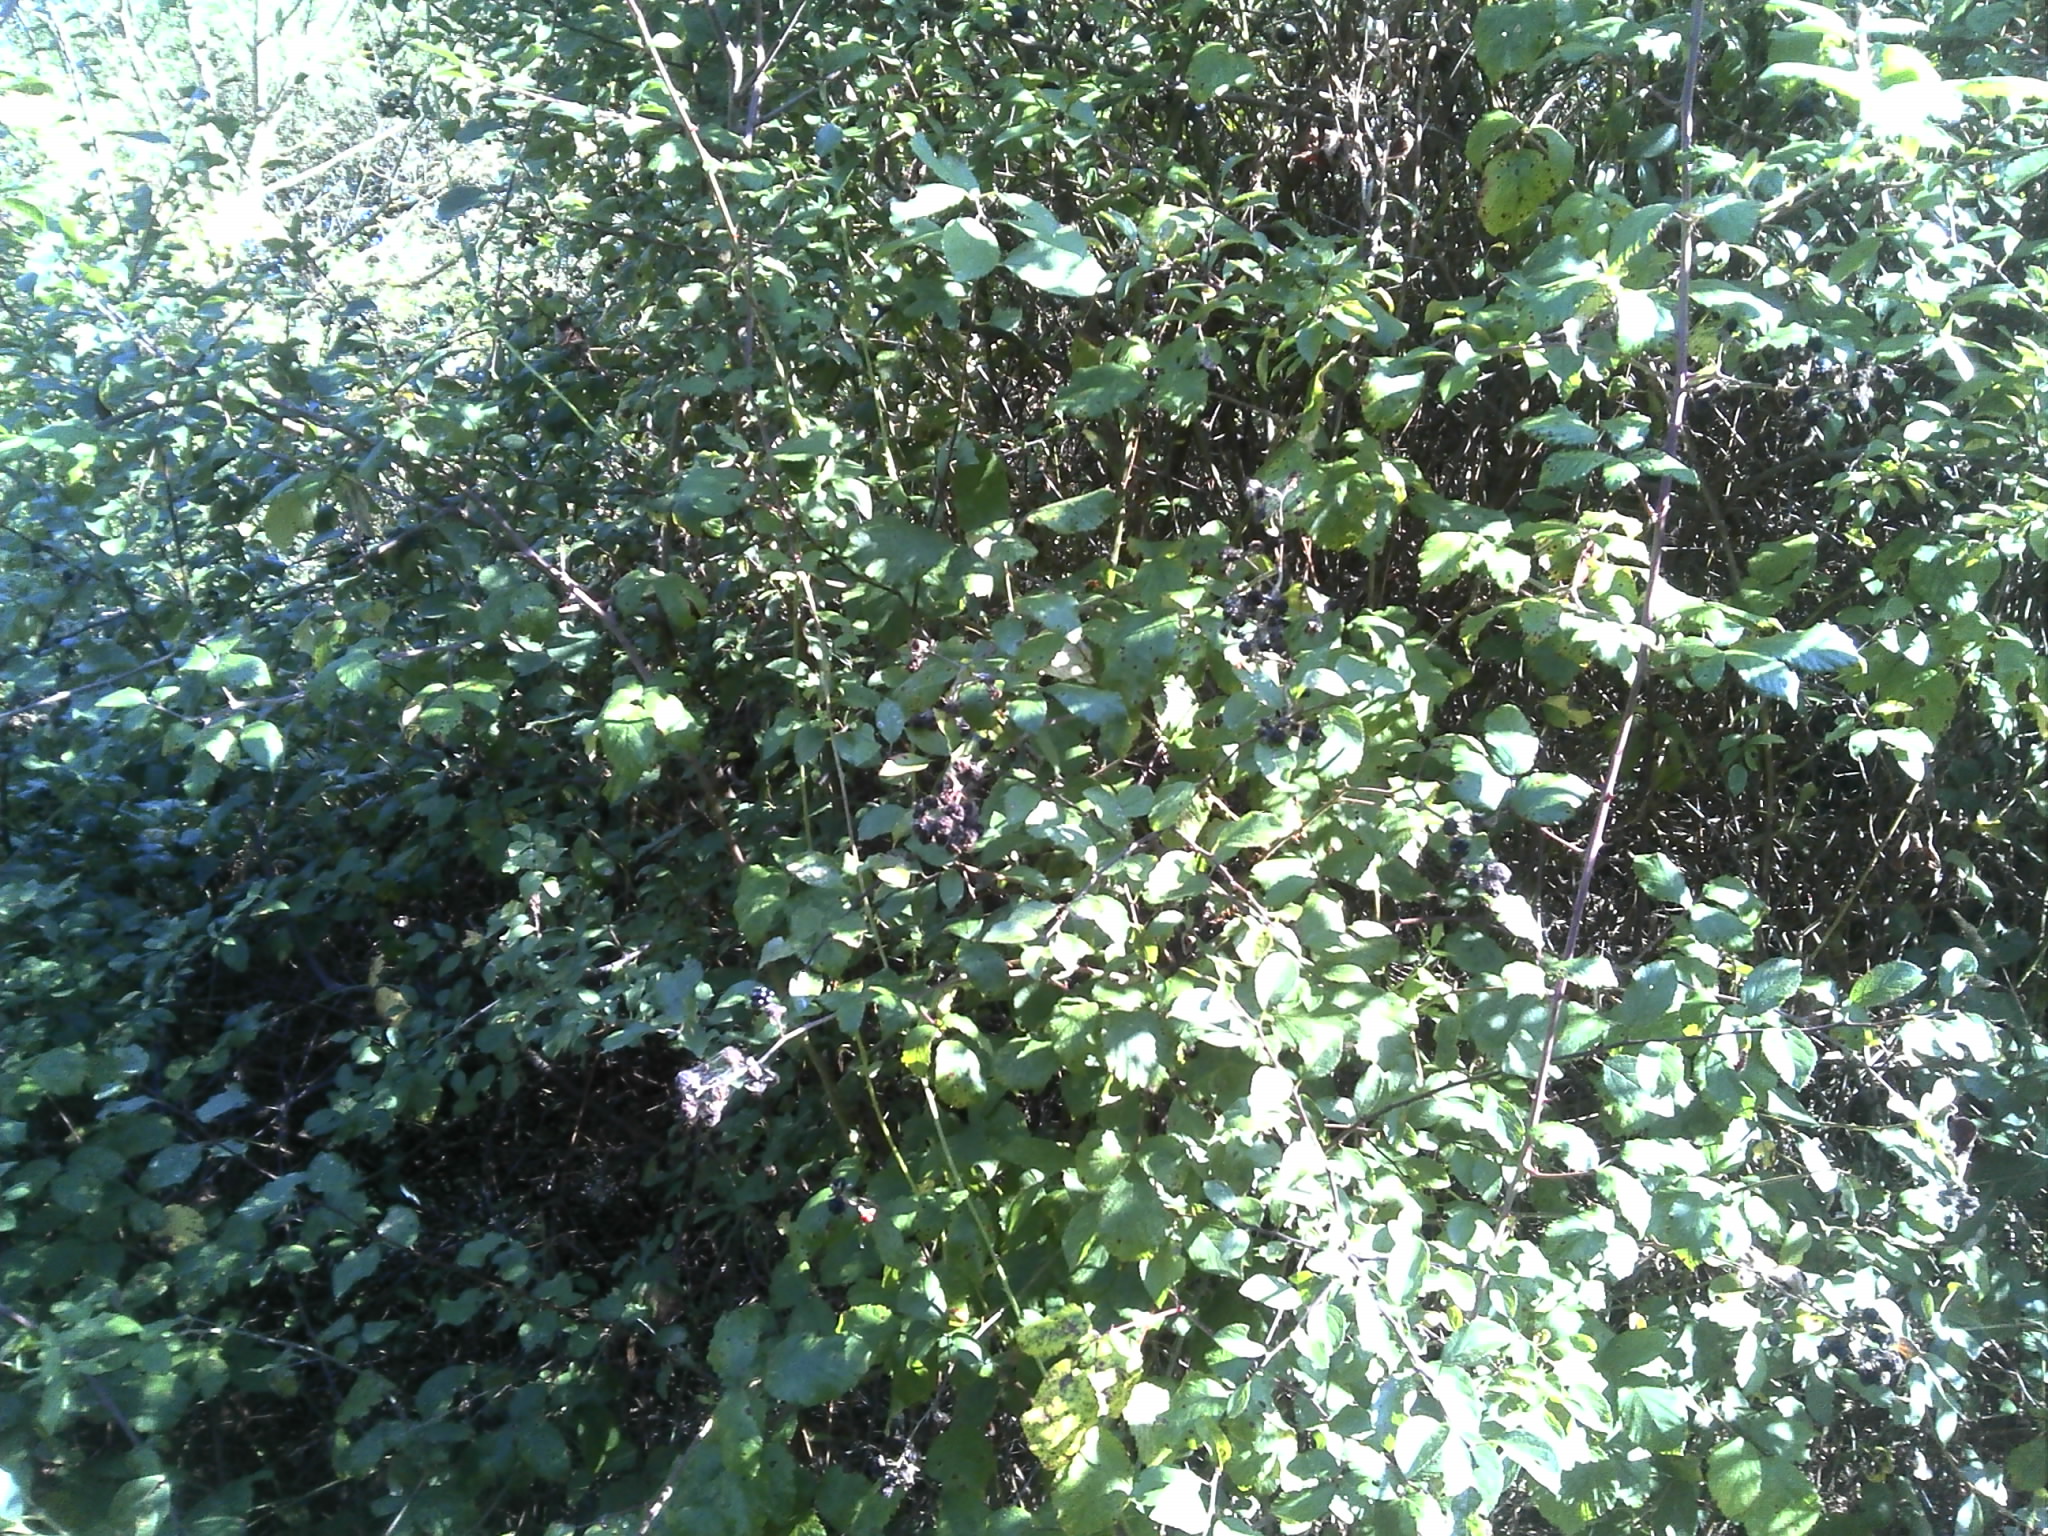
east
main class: Woodland
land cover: Broadleaved woodland
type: mesophytic deciduous forest
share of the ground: > 75 %
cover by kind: broadleaved forest trees 90 %, herbaceous plants 10 %
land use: Forestry
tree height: > 5 m
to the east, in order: Broadleaved woodland; Fences; Grass margins; Abandoned hedges; Grass margins; Tracks; Grass margins; Abandoned hedges; Grassland without tree/shrub cover; Abandoned hedges; Grassland without tree/shrub cover
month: October
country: FR
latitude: 47.5061
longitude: -1.0167
